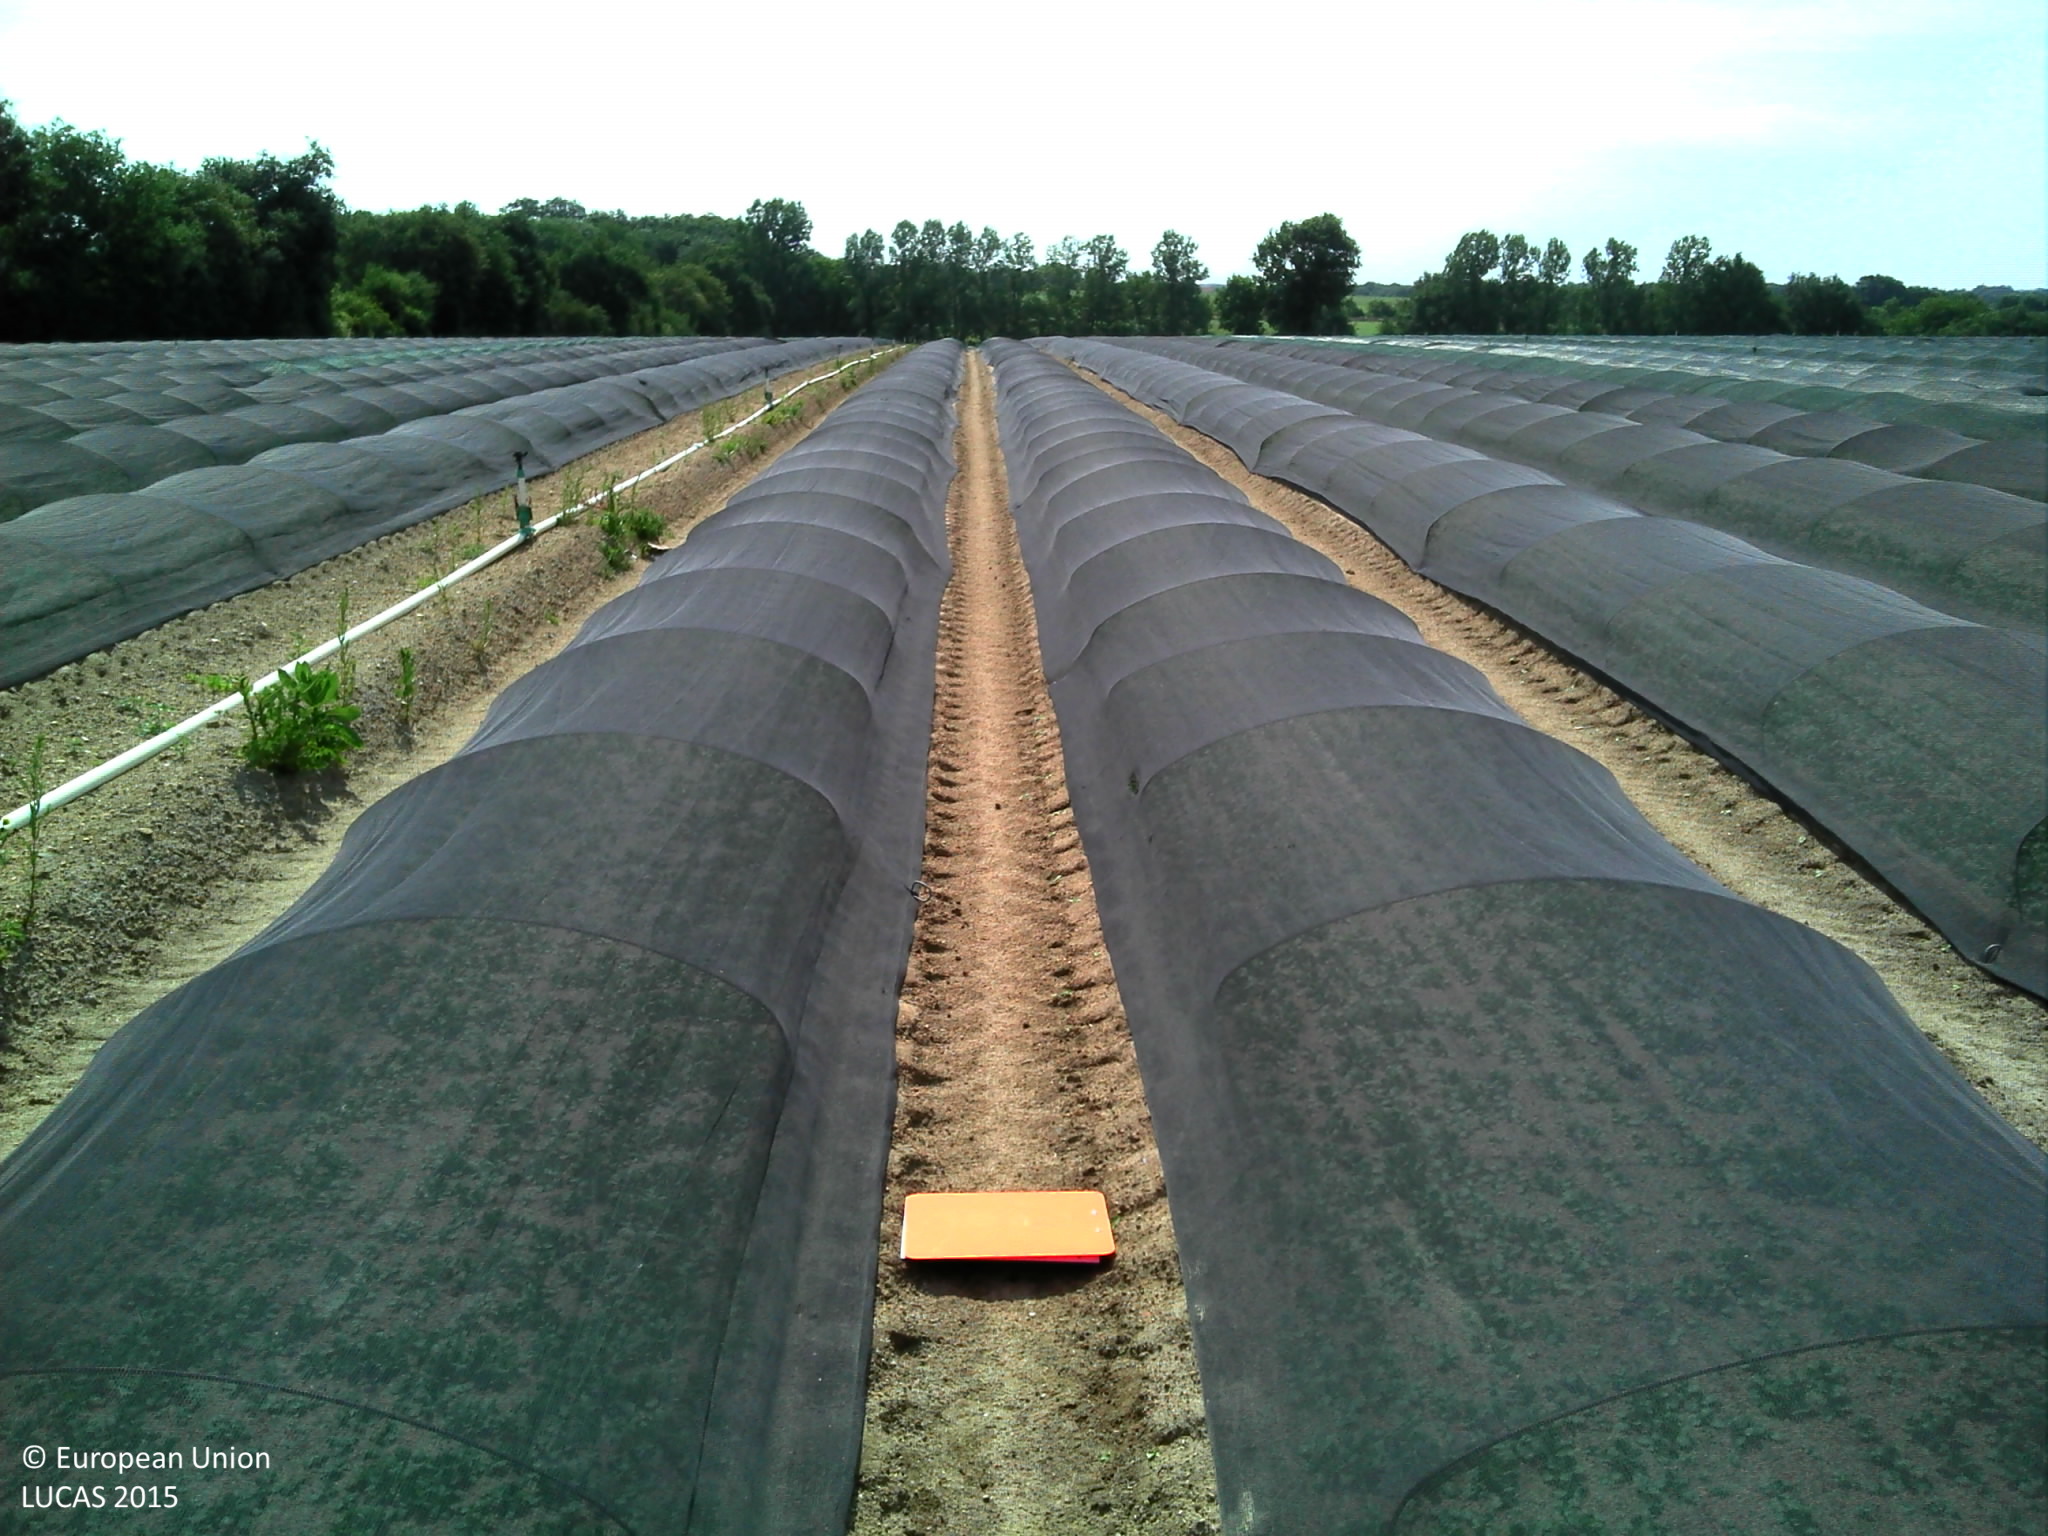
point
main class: Cropland
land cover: Other fresh vegetables
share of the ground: > 75 %
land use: Agriculture (excluding fallow land and kitchen gardens)
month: June
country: FR
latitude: 47.1263
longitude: -1.5230
